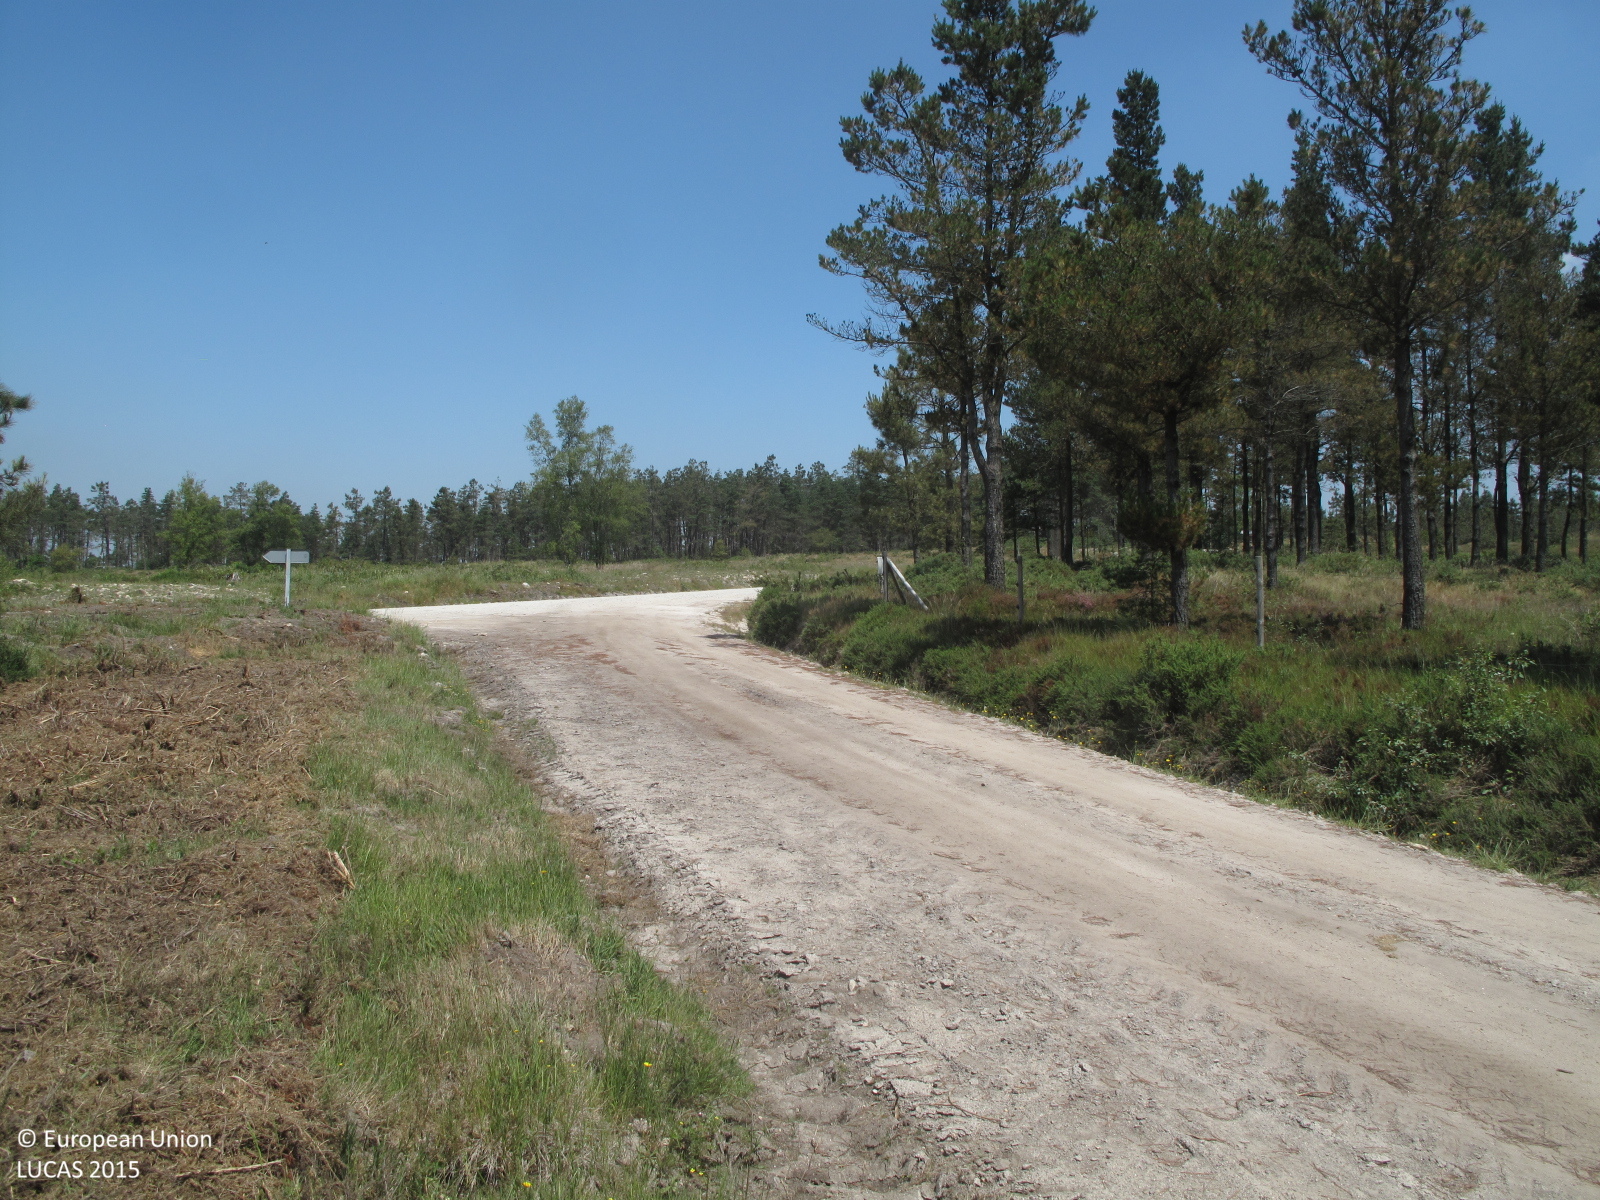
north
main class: Woodland
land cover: Pine dominated mixed woodland
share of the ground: 10 - 25 %
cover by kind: shrubs 60 %, herbaceous plants 30 %, coniferous forest trees 5 %, broadleaved forest trees 5 %
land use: Forestry
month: June
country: ES
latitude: 43.2336
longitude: -7.9330
